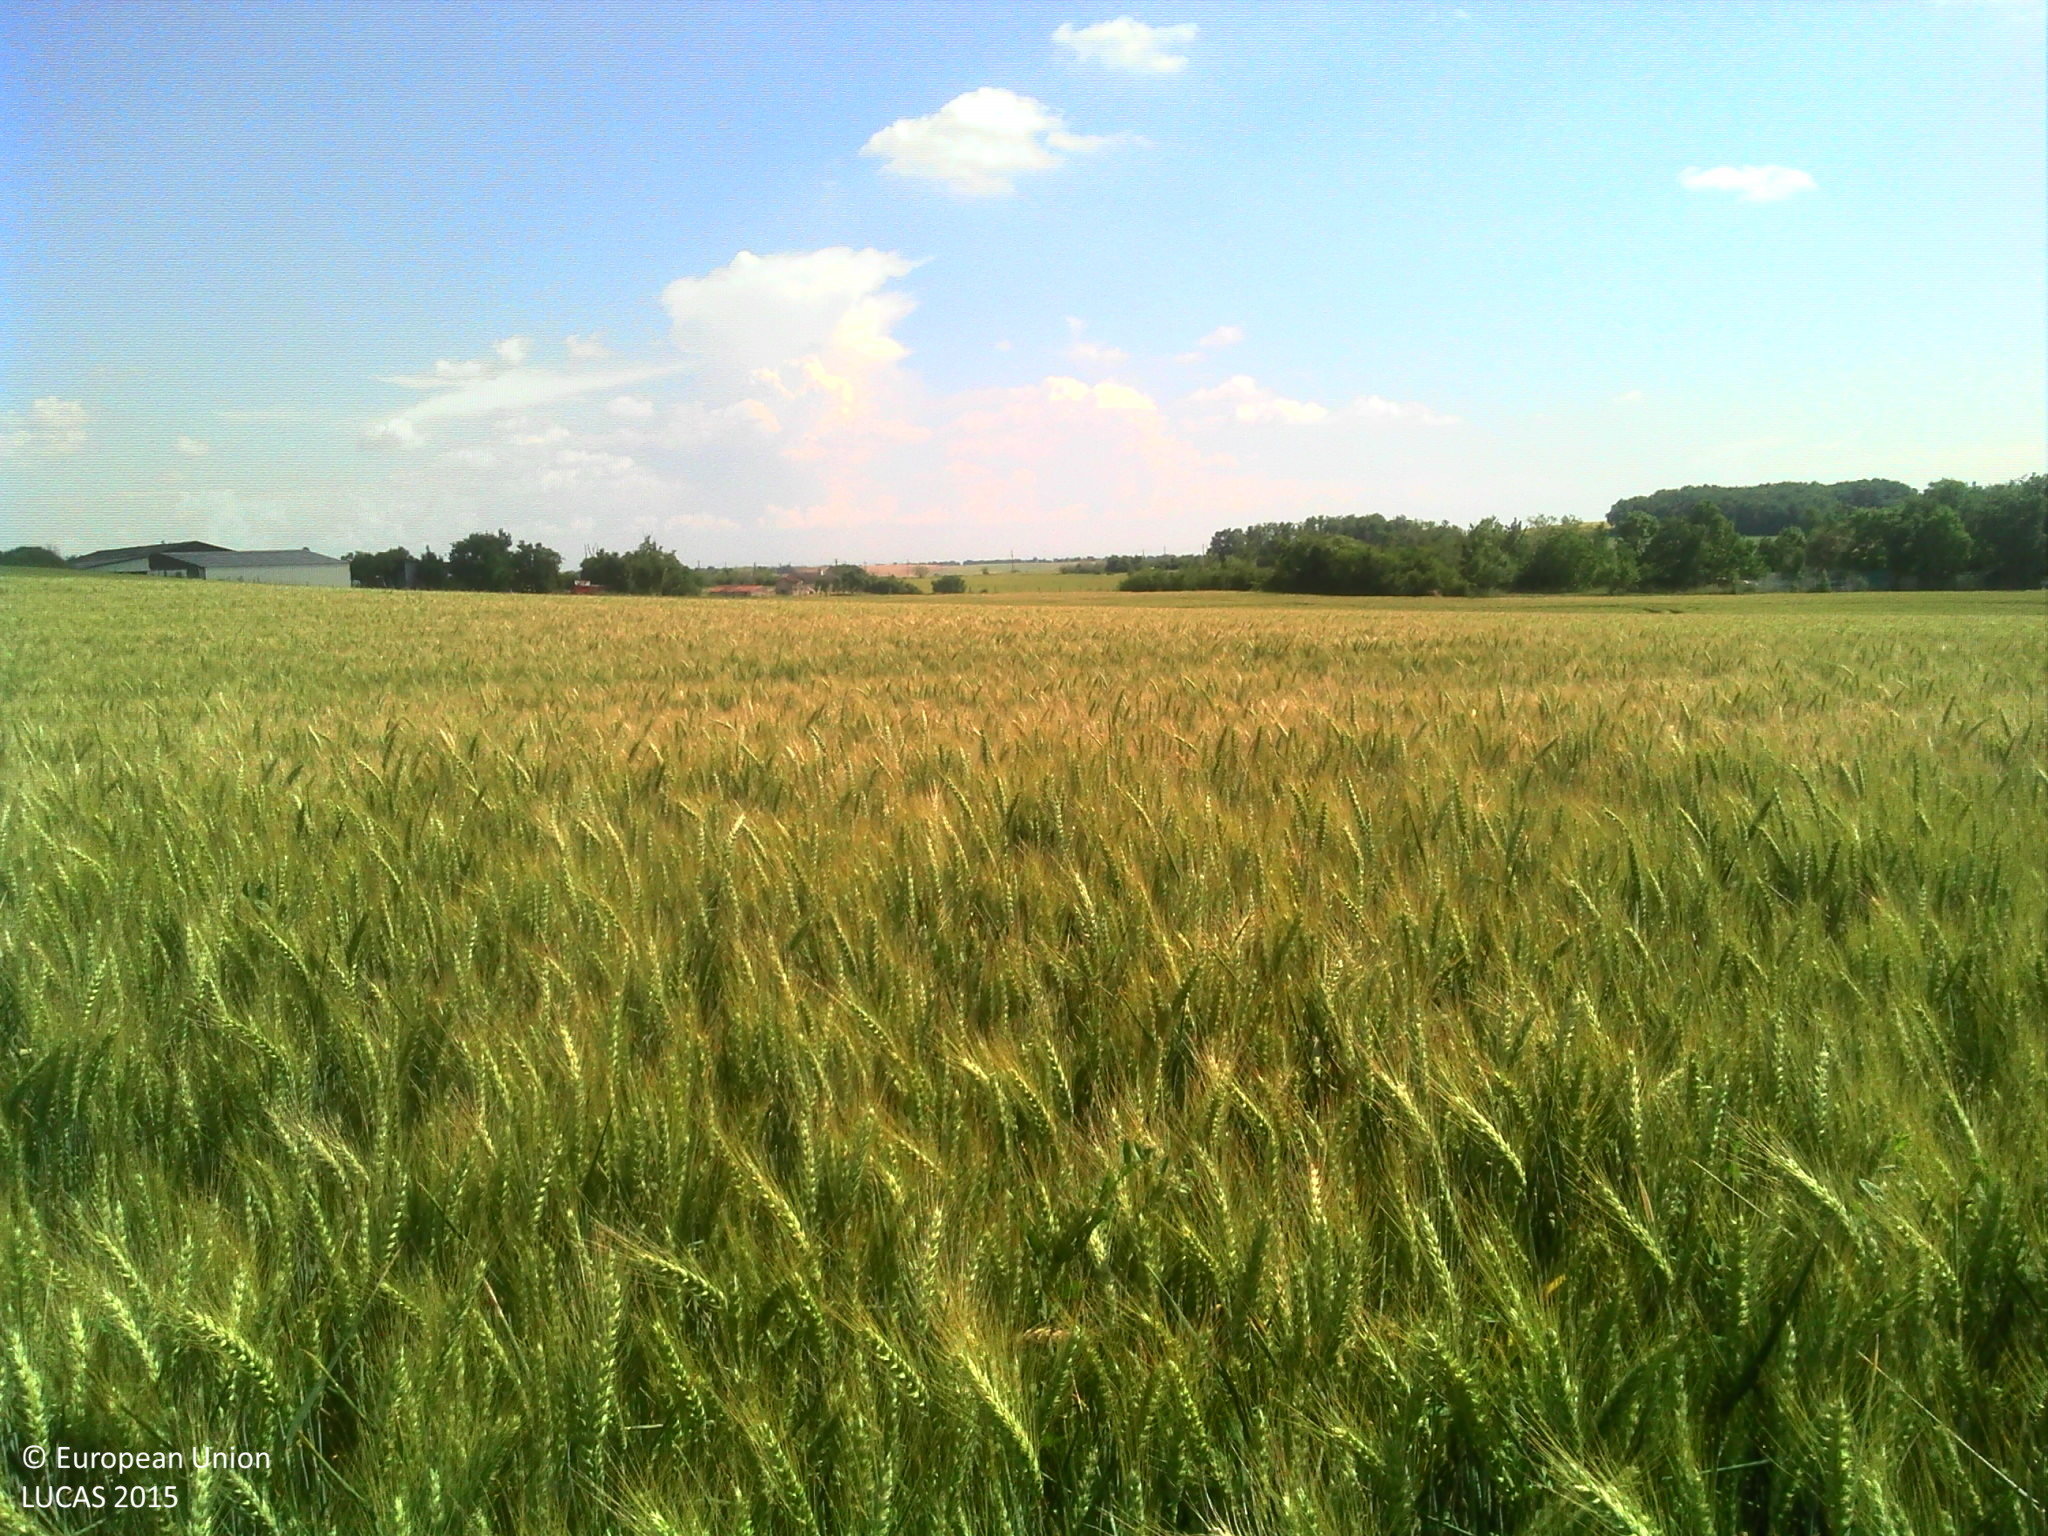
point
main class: Cropland
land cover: Common wheat
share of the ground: > 75 %
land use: Agriculture (excluding fallow land and kitchen gardens)
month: June
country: FR
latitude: 43.8501
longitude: 2.1049
